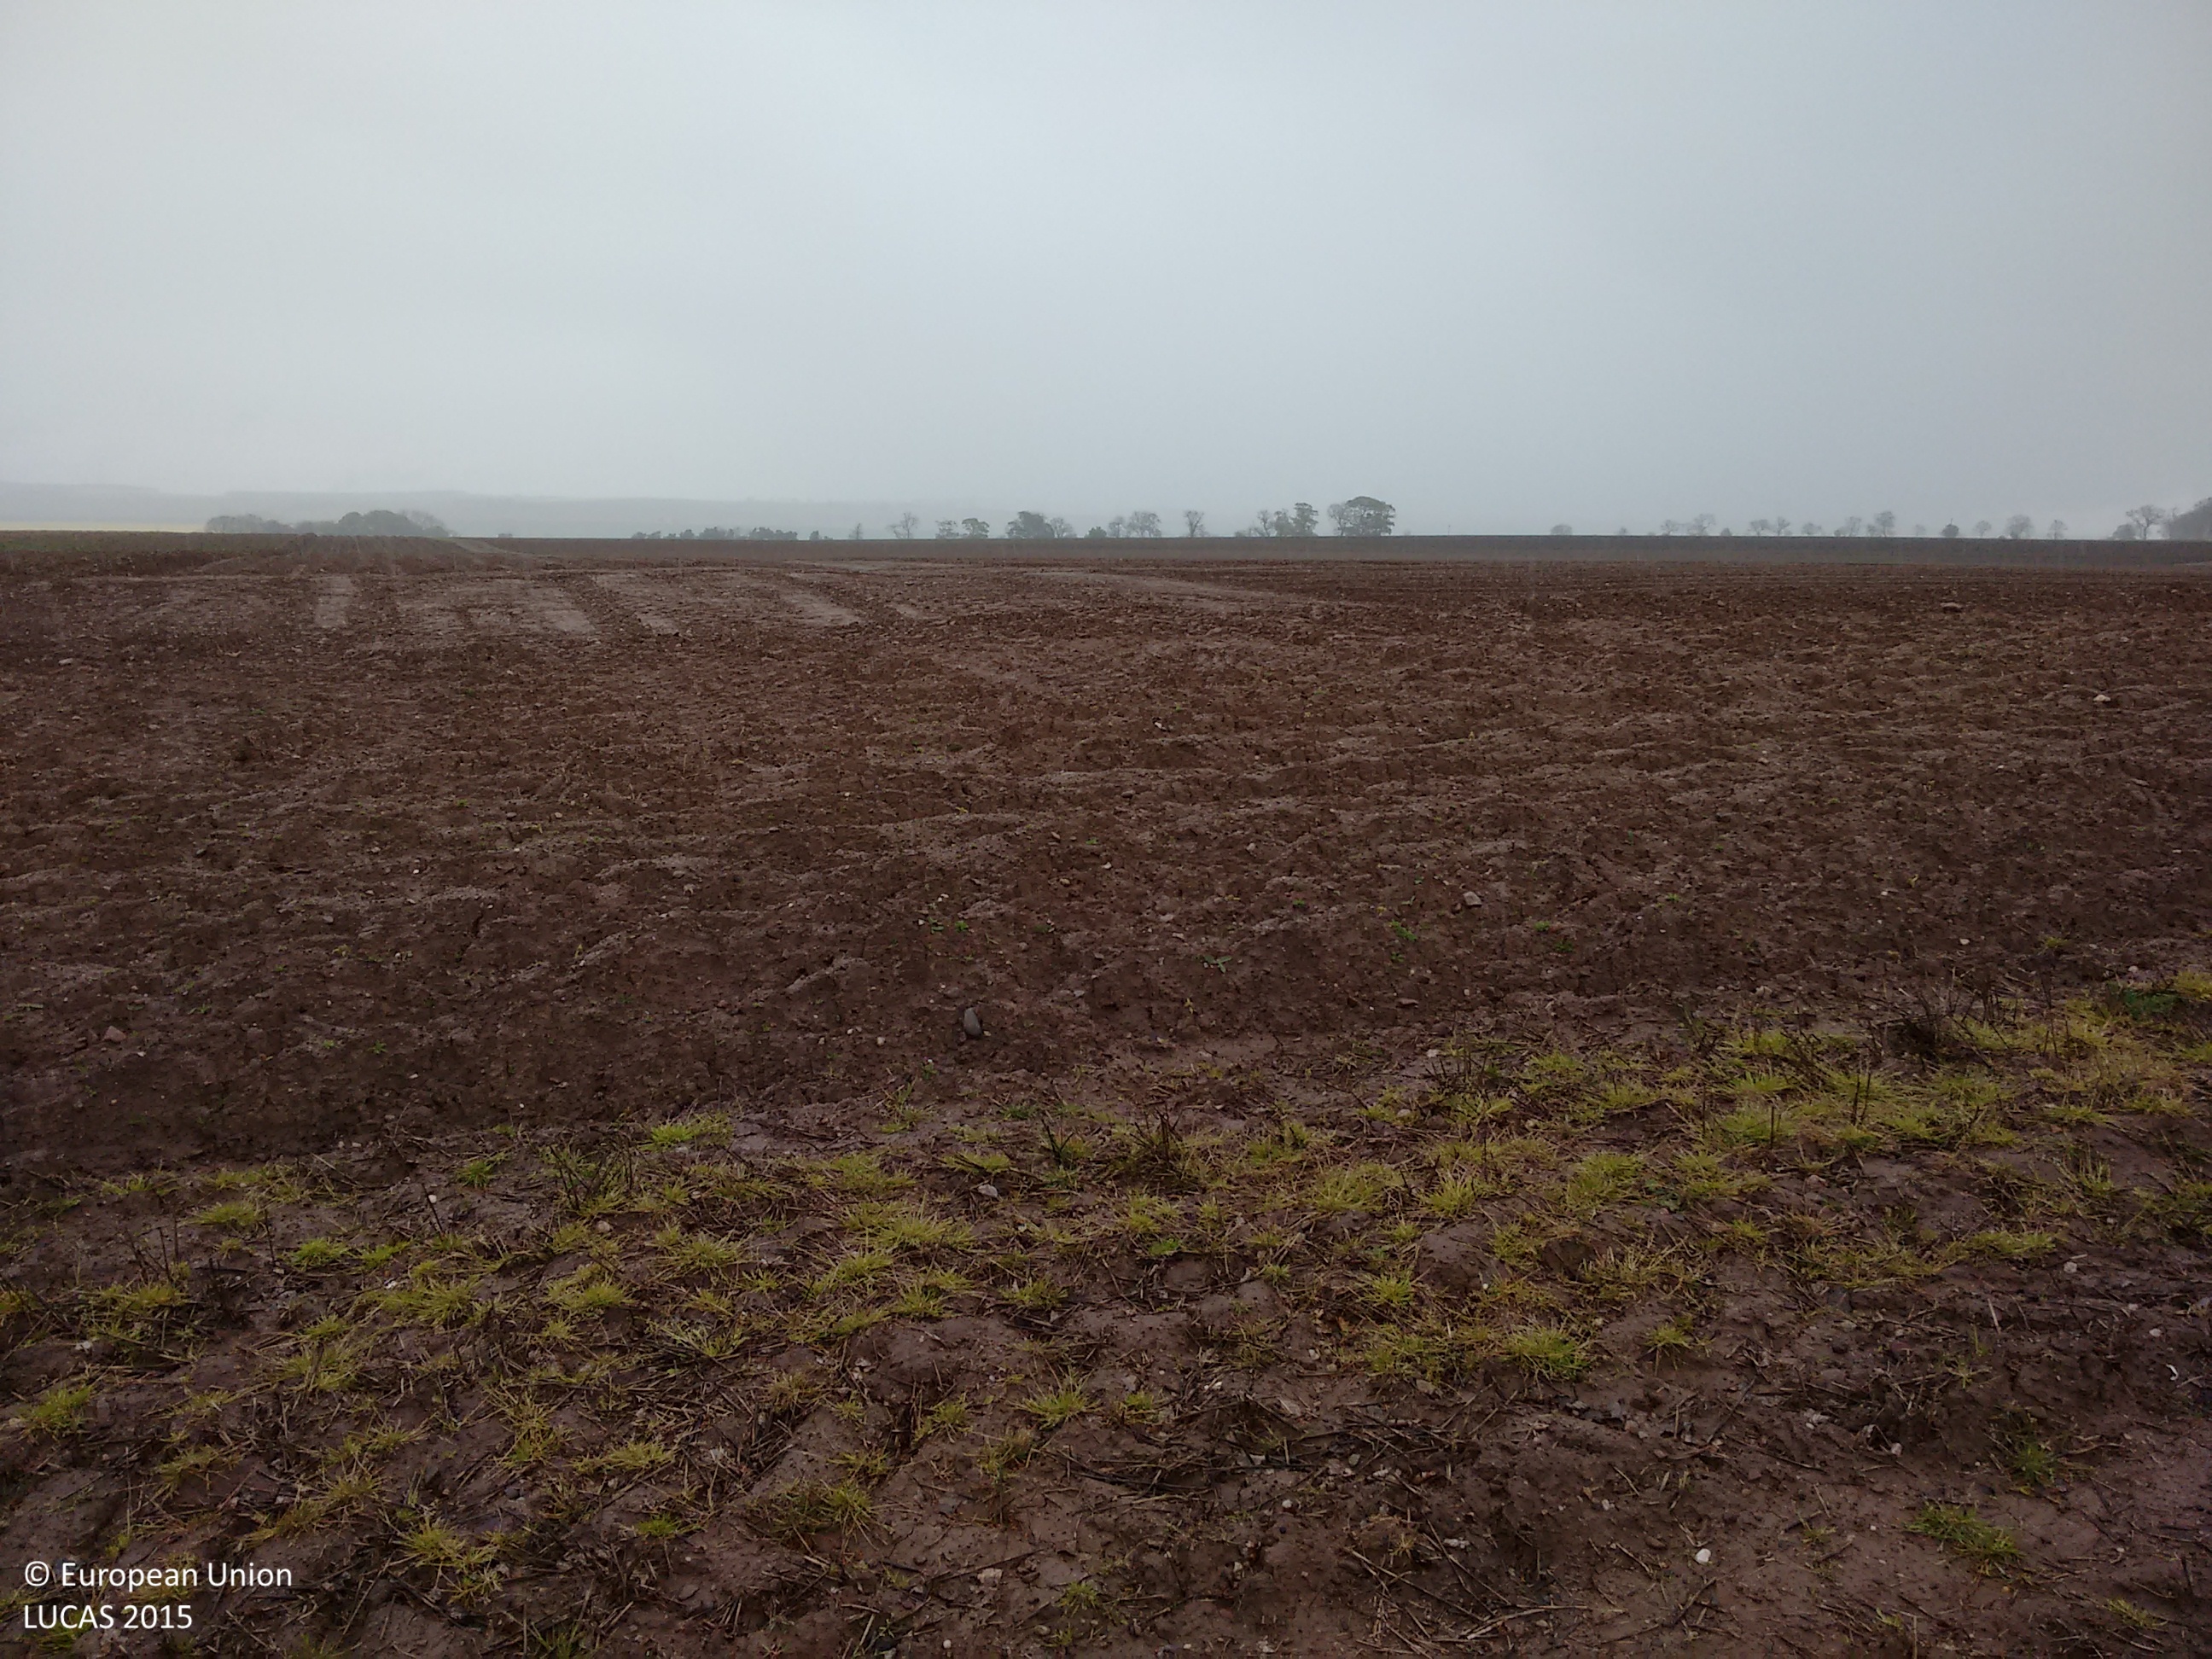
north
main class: Grassland
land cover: Spontaneously vegetated surfaces
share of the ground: 10 - 25 %
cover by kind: unconsolidated bare surface 60 %, herbaceous plants 40 %
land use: Agriculture (excluding fallow land and kitchen gardens)
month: May
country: GB
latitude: 56.6070
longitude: -2.5531
